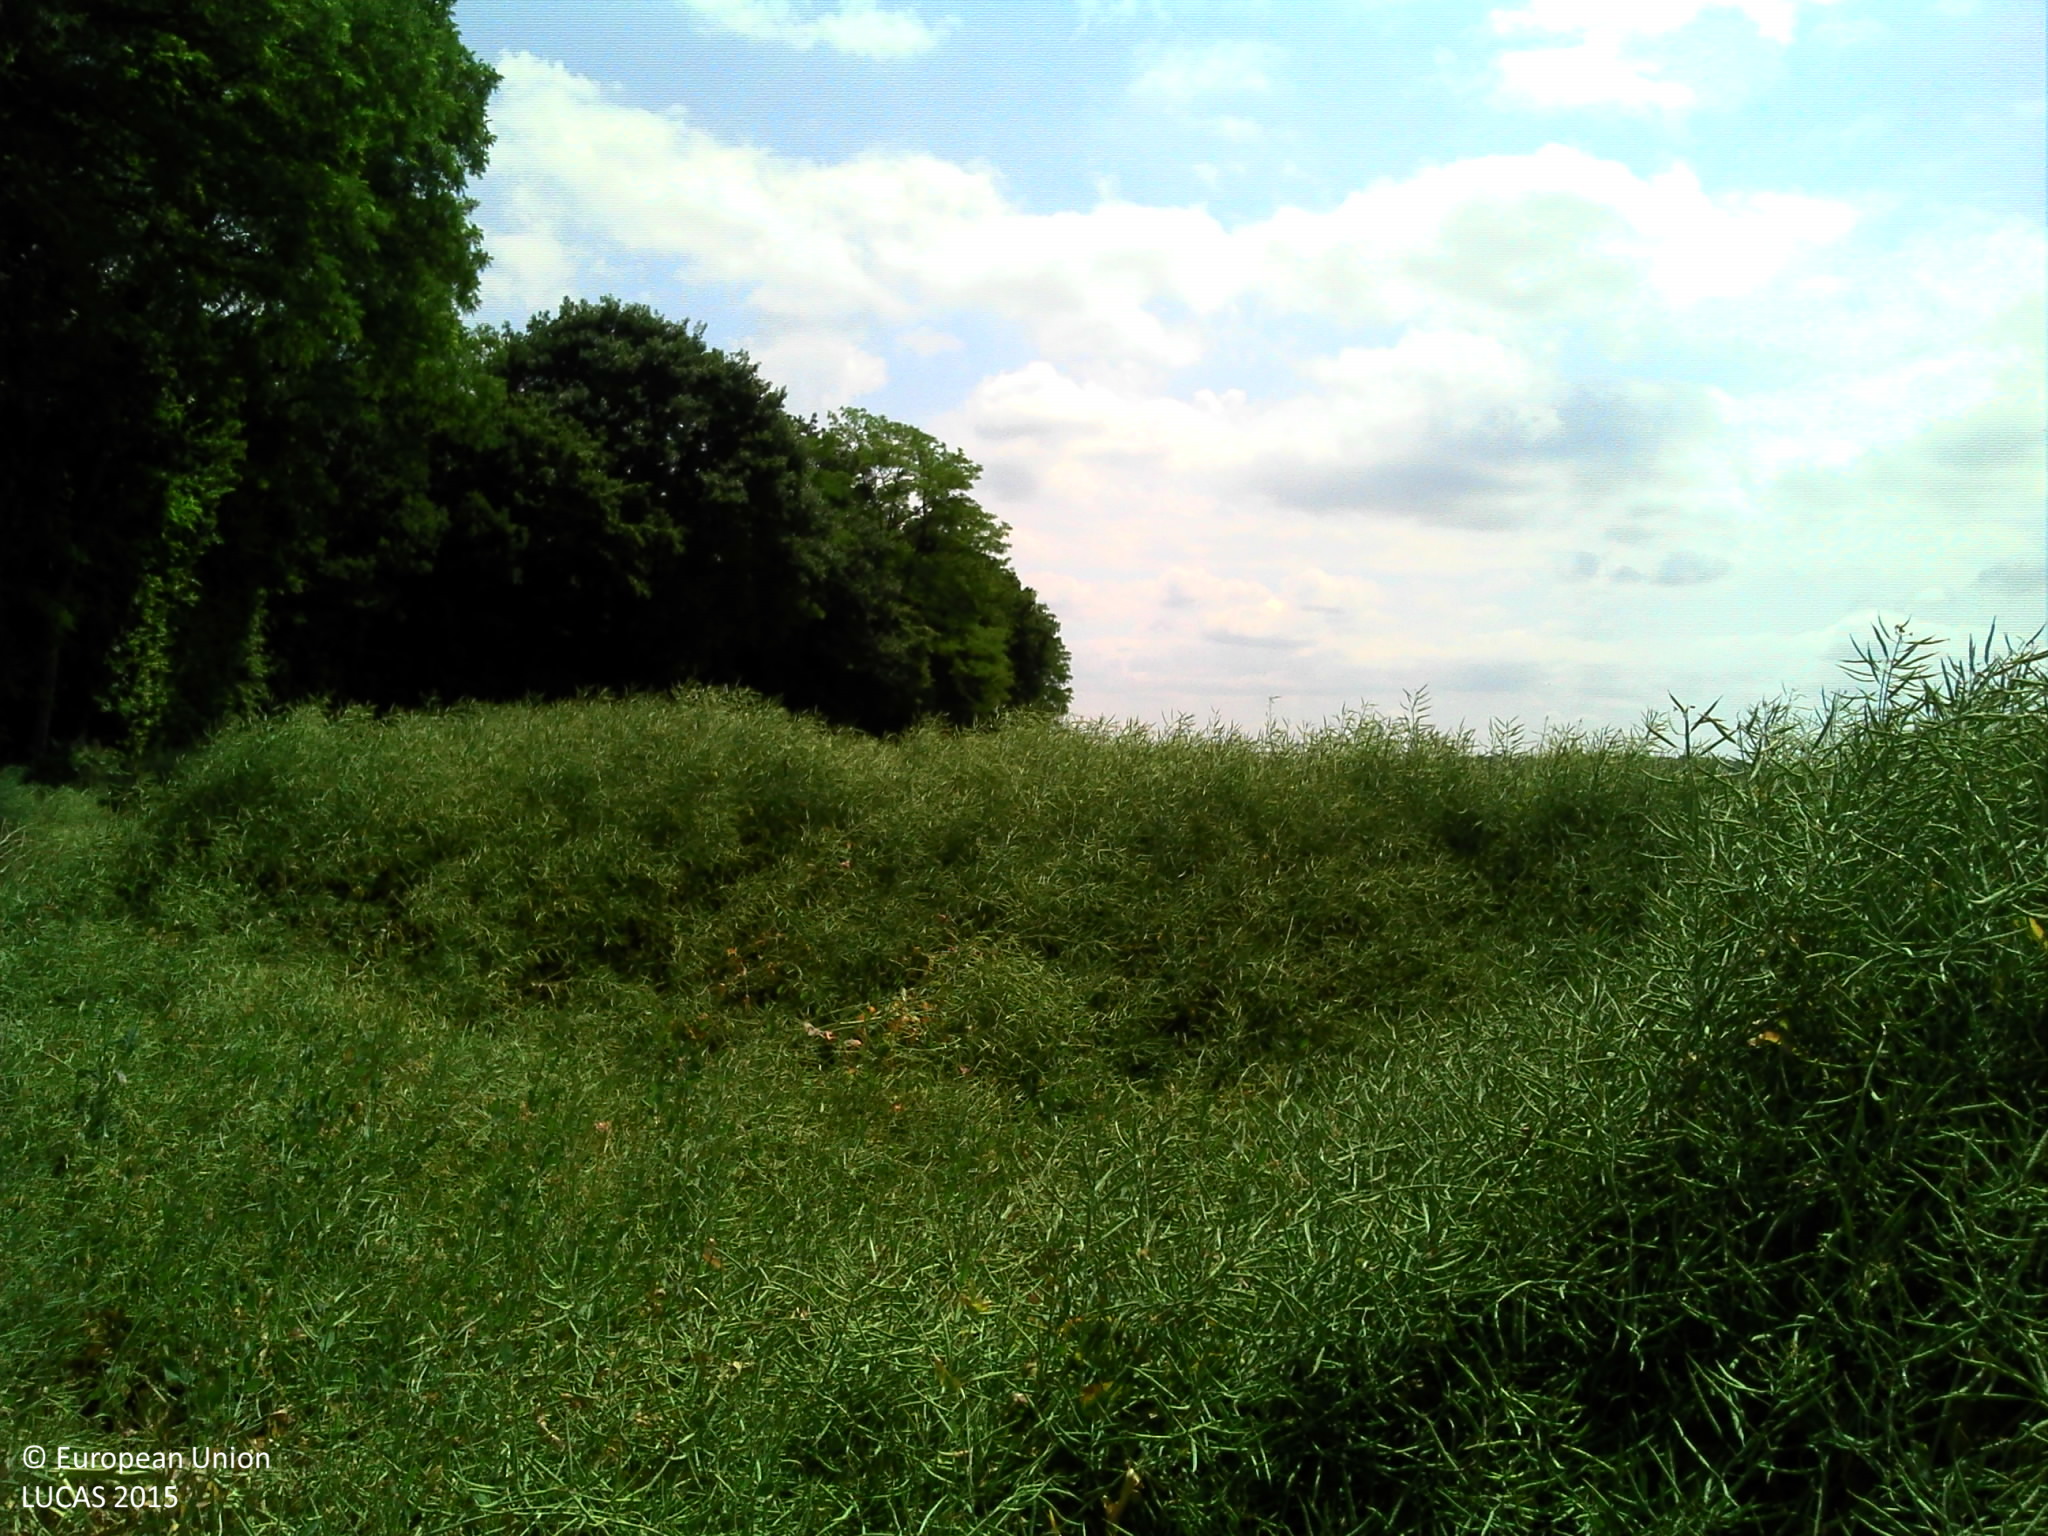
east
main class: Cropland
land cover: Rape and turnip rape
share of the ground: > 75 %
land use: Agriculture (excluding fallow land and kitchen gardens)
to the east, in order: Rape and turnip rape; Grass margins; Broadleaved woodland; Tracks; Broadleaved woodland
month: June
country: FR
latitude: 47.3303
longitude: 5.3032
